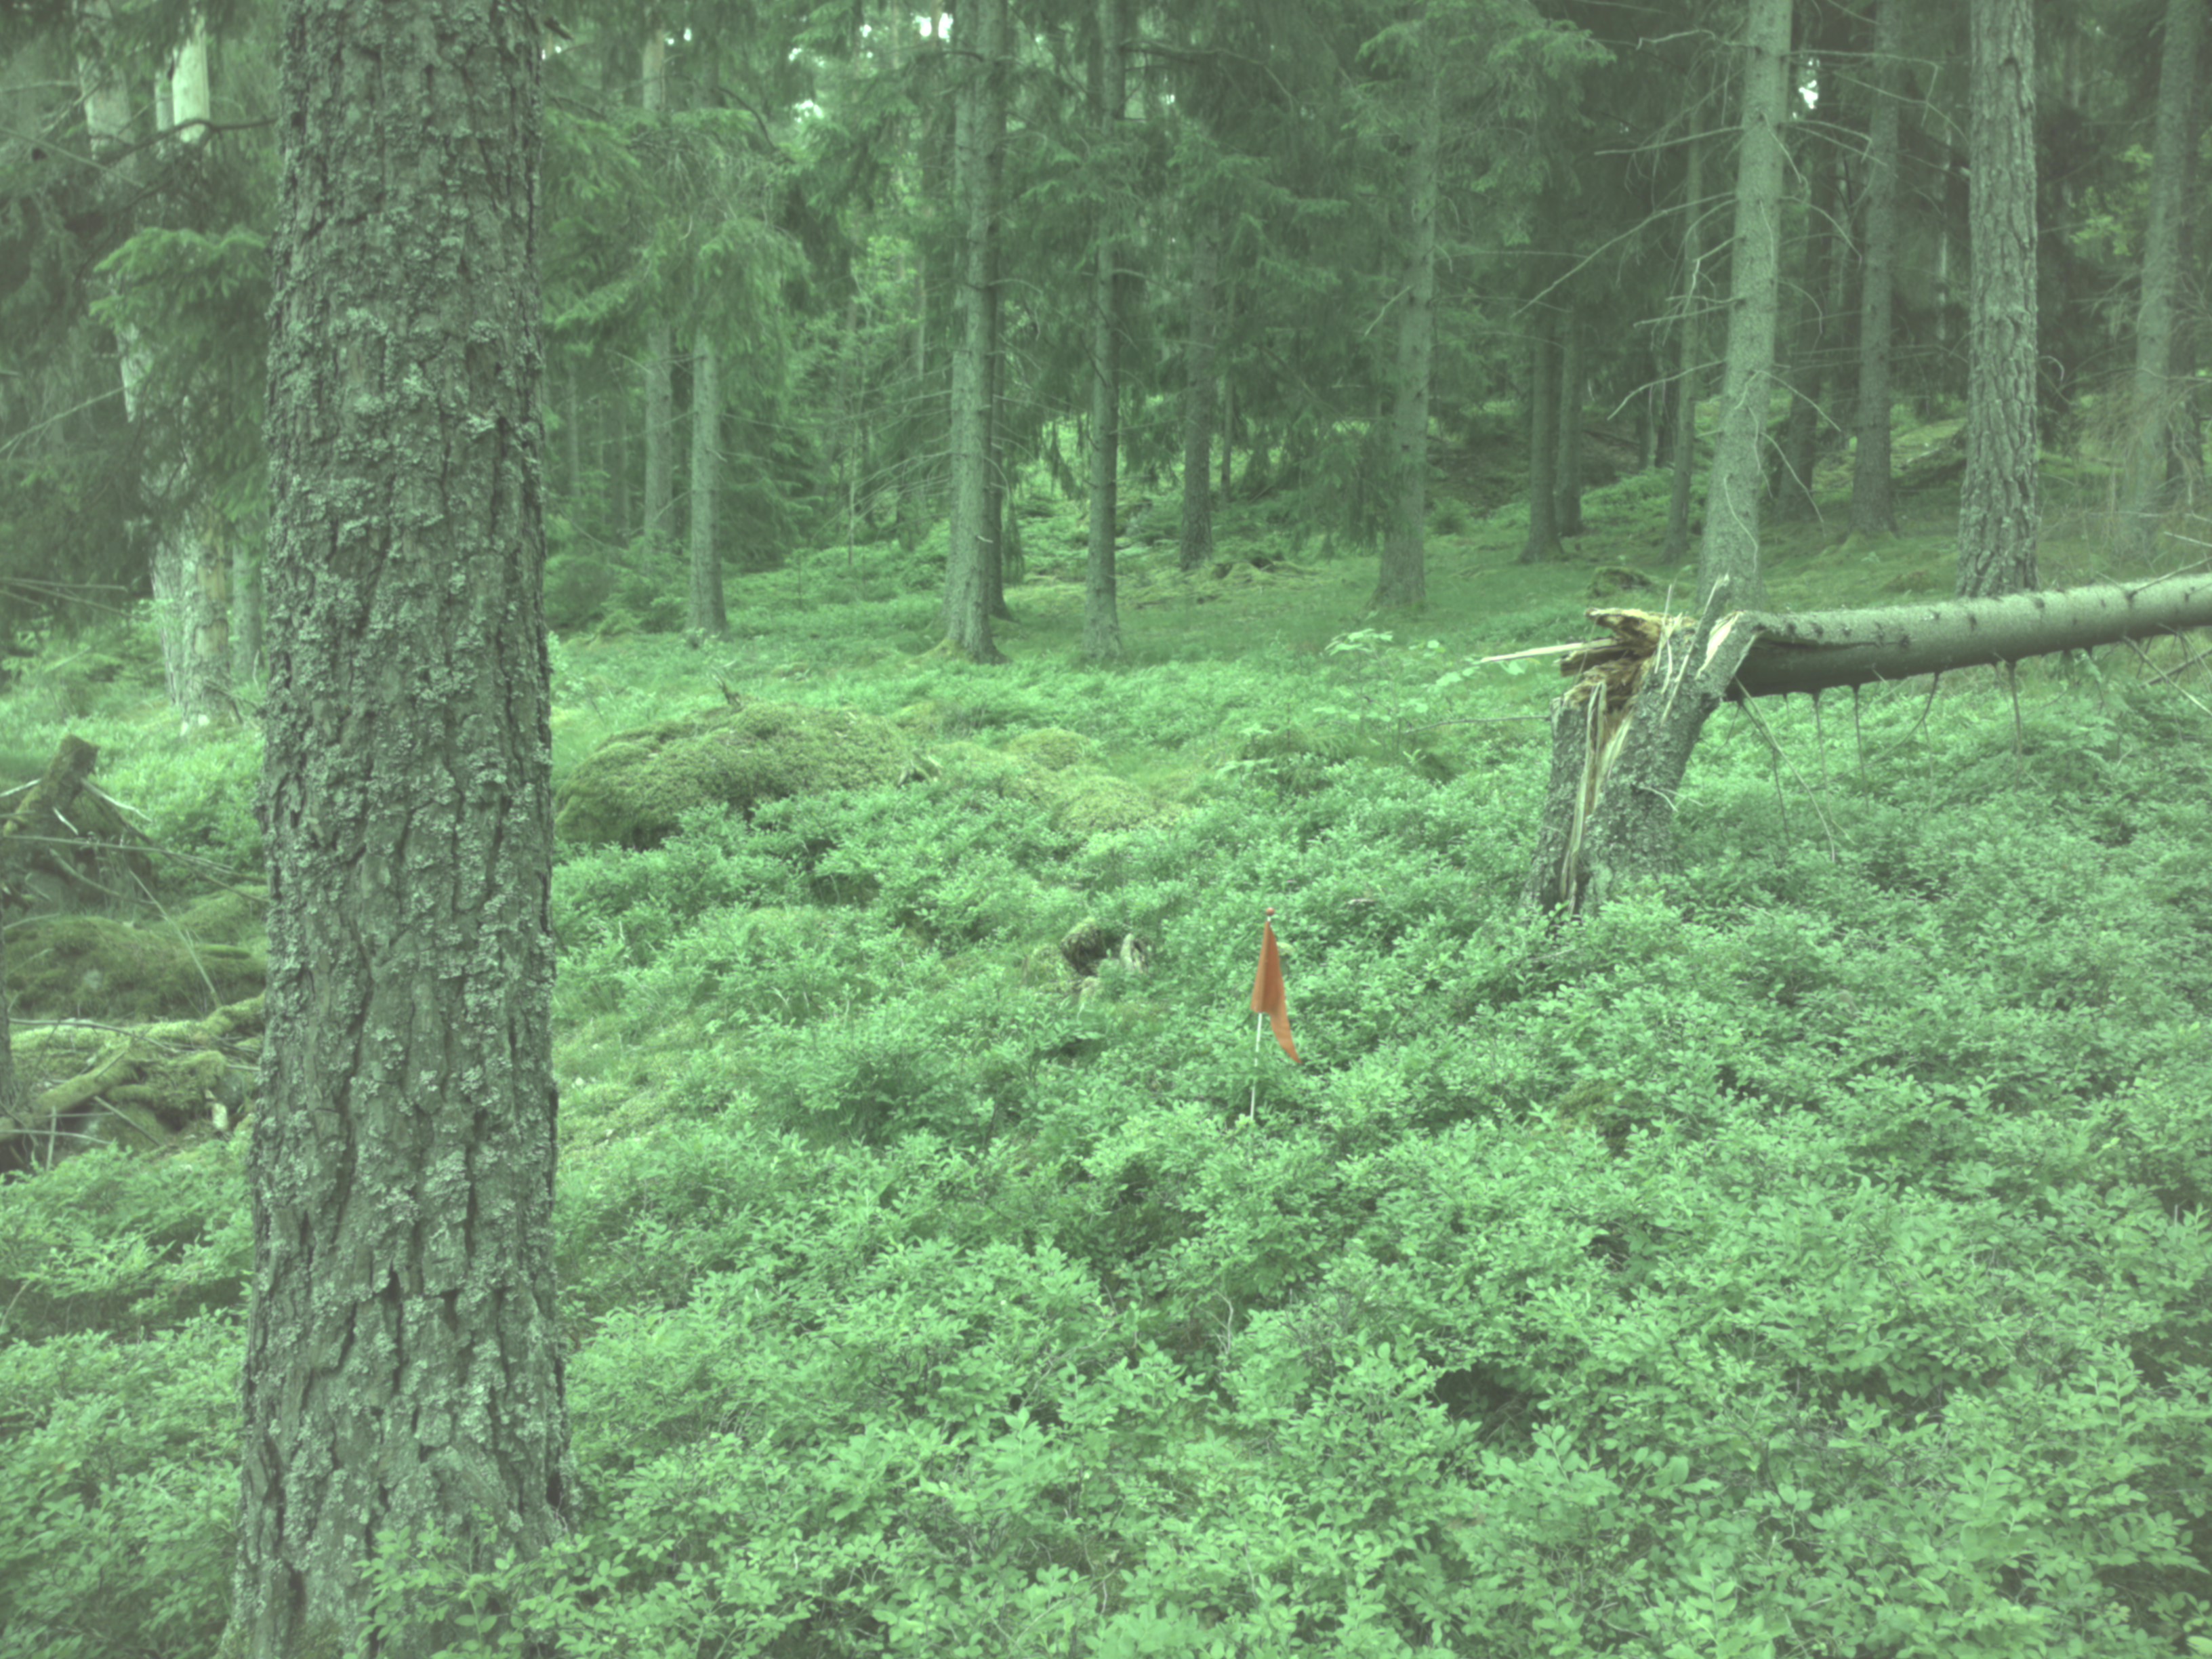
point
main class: Woodland
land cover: Spruce dominated coniferous woodland
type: boreal forest
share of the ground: 50 - 75 %
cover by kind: coniferous forest trees 60 %, shrubs 30 %, lichens and mosses 10 %
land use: Forestry
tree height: > 5 m
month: June
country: SE
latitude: 59.2818
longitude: 17.3850
